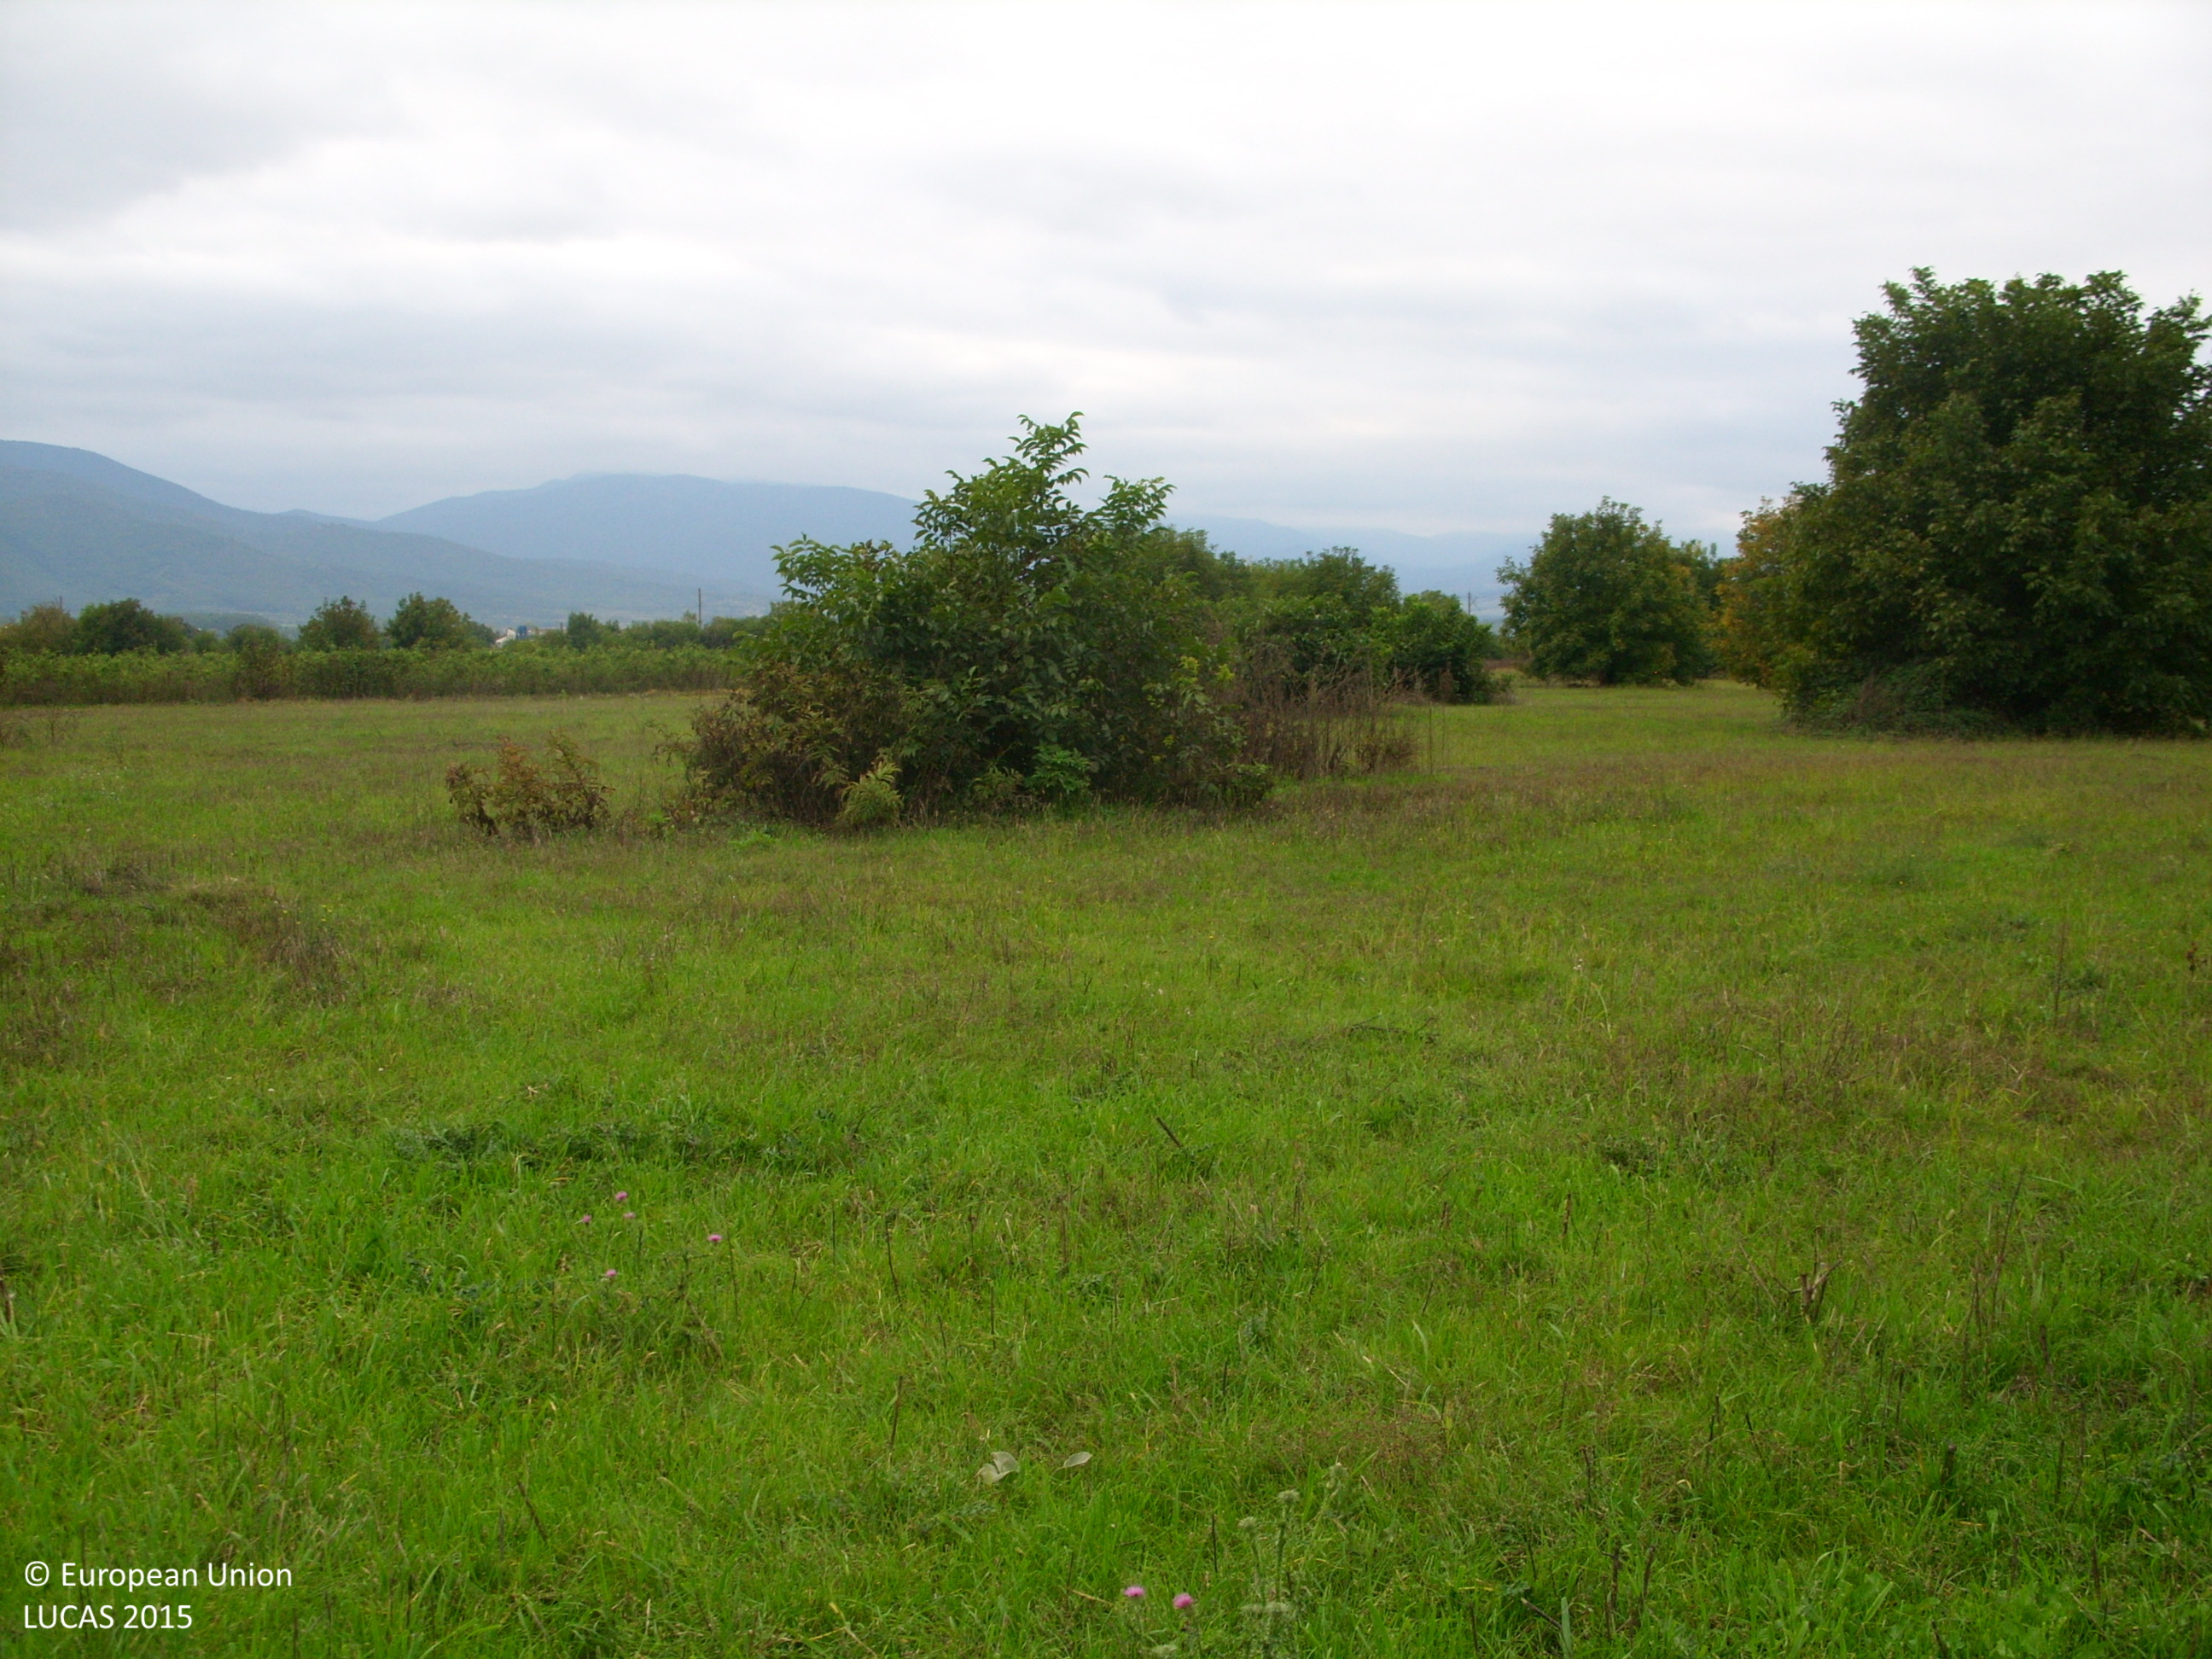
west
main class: Grassland
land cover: Grassland without tree/shrub cover
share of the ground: > 75 %
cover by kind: herbaceous plants 100 %
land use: Agriculture (excluding fallow land and kitchen gardens)
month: October
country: BG
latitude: 42.6089
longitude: 24.7701
